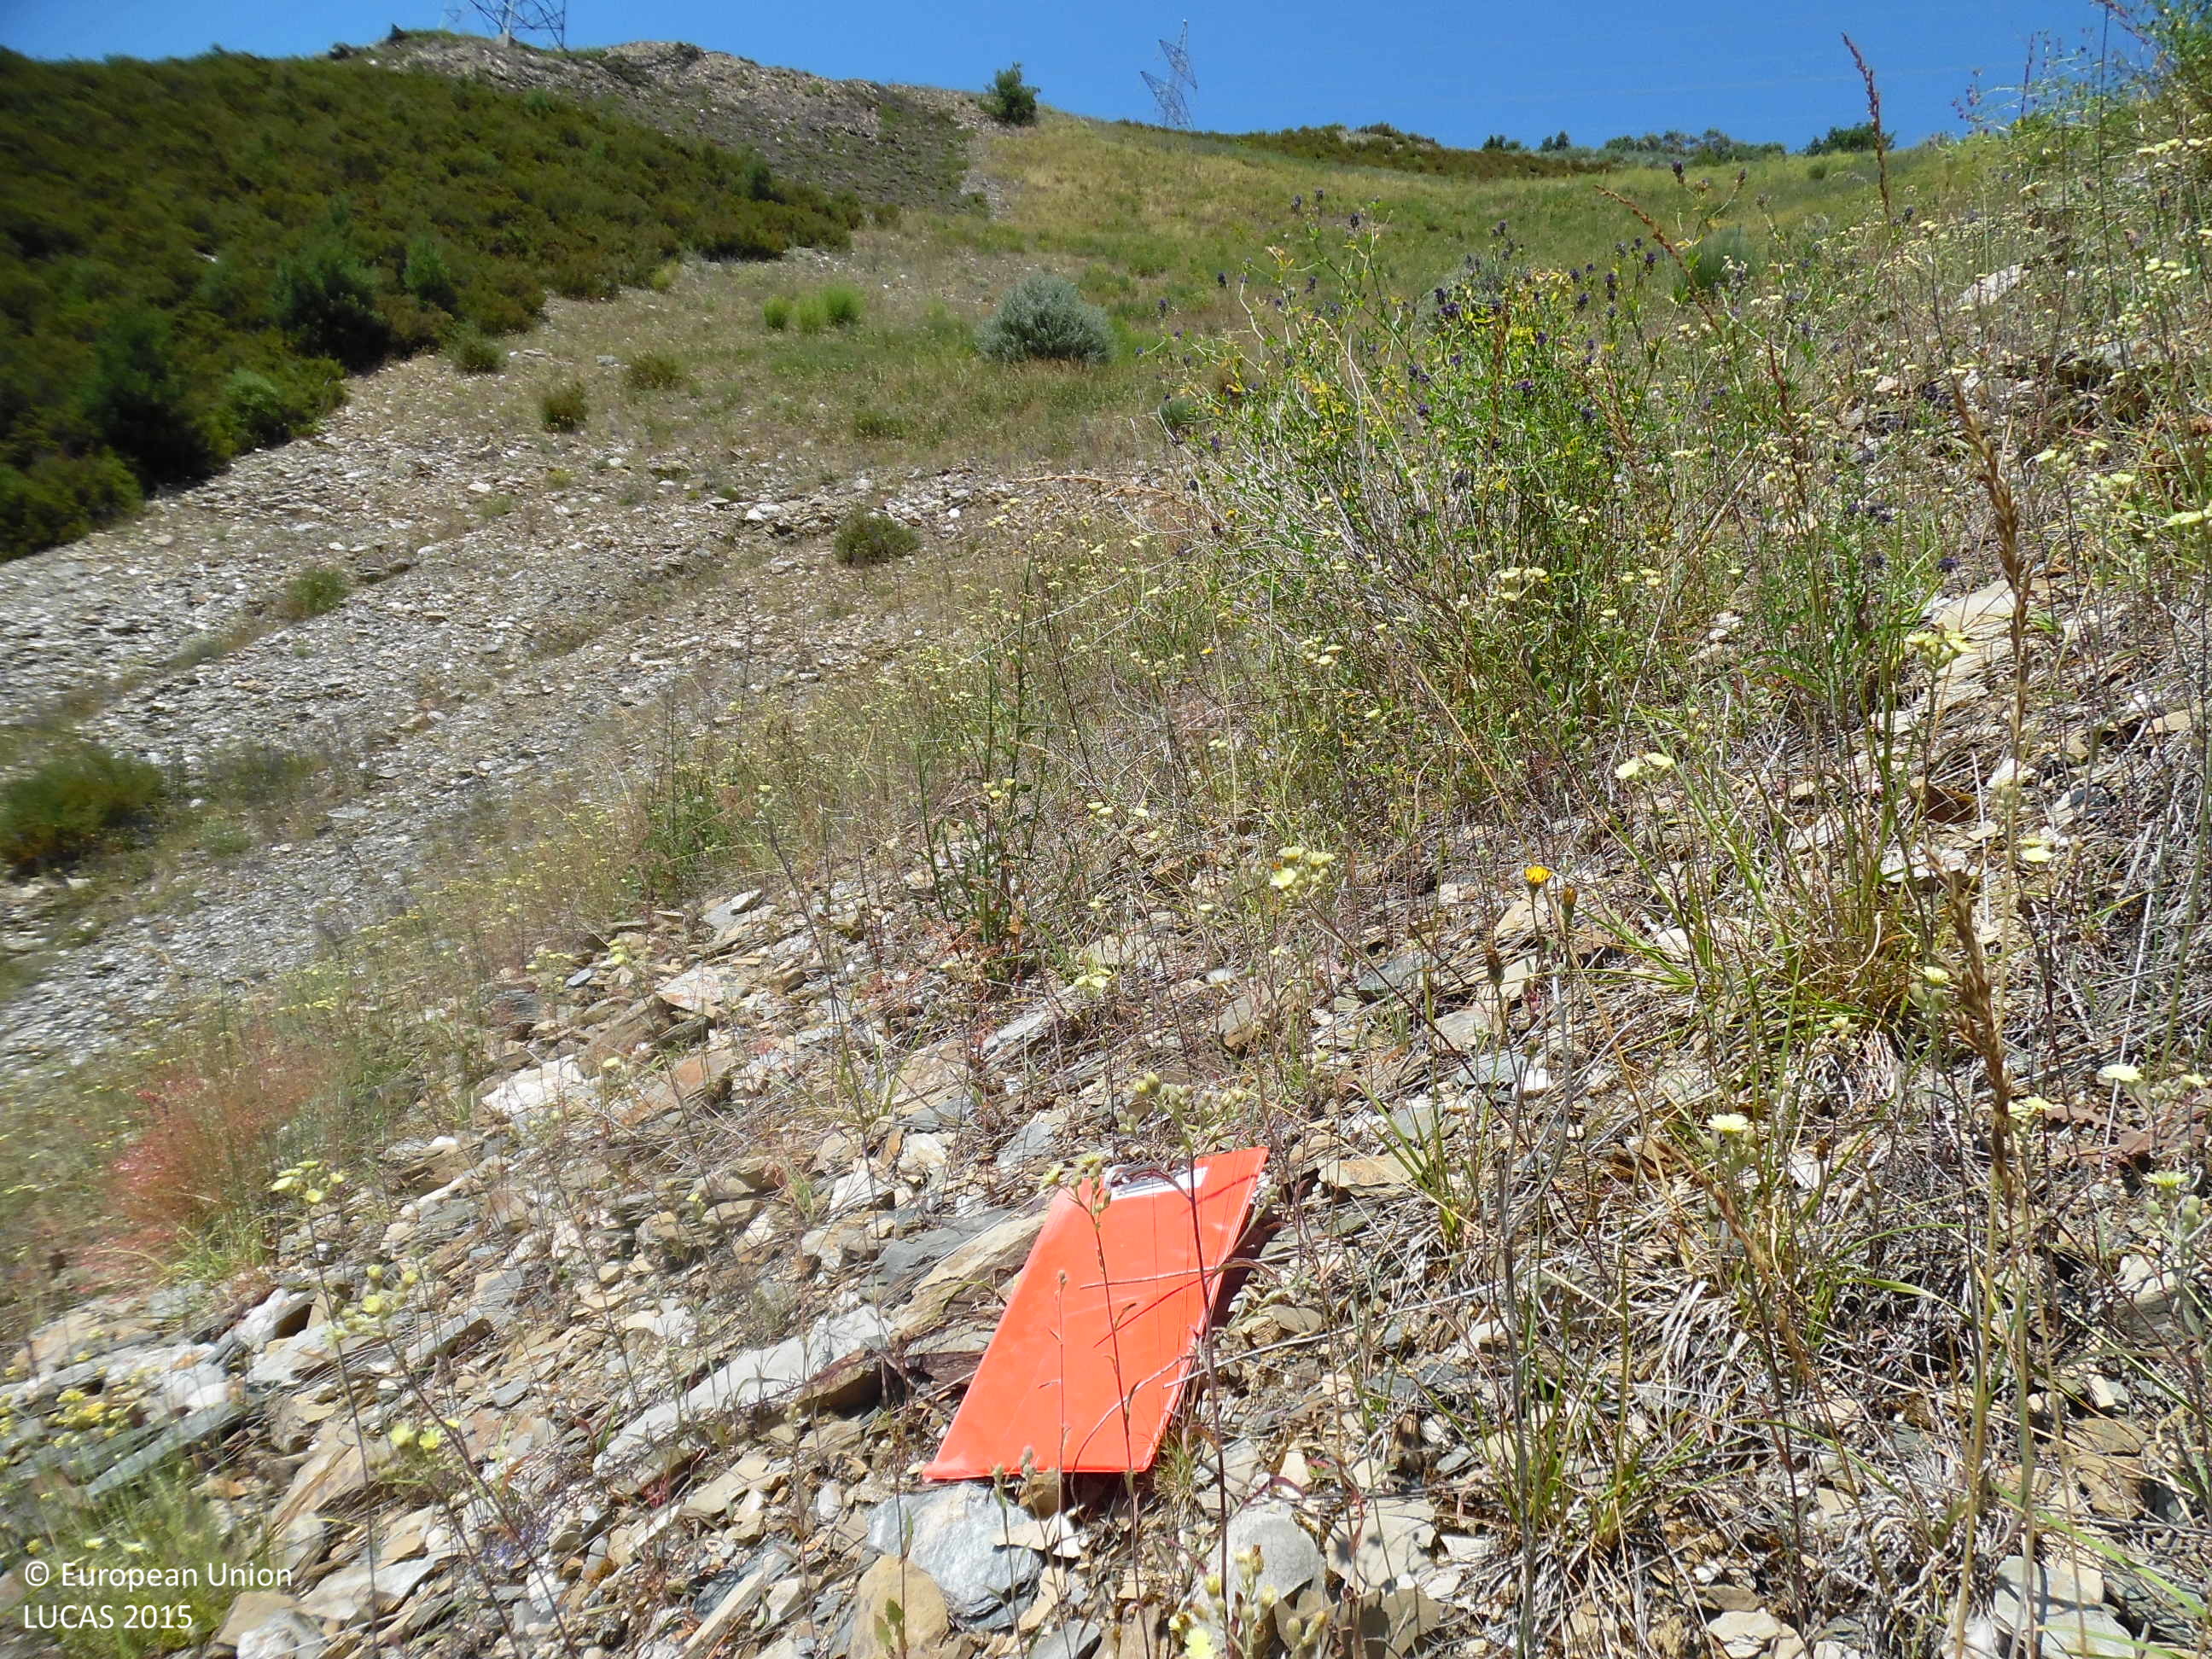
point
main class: Grassland
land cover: Grassland with sparse tree/shrub cover
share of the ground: > 75 %
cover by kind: herbaceous plants 95 %, broadleaved forest trees 5 %
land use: Abandoned areas
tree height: < 5 m
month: June
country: ES
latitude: 42.6572
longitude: -6.9025
